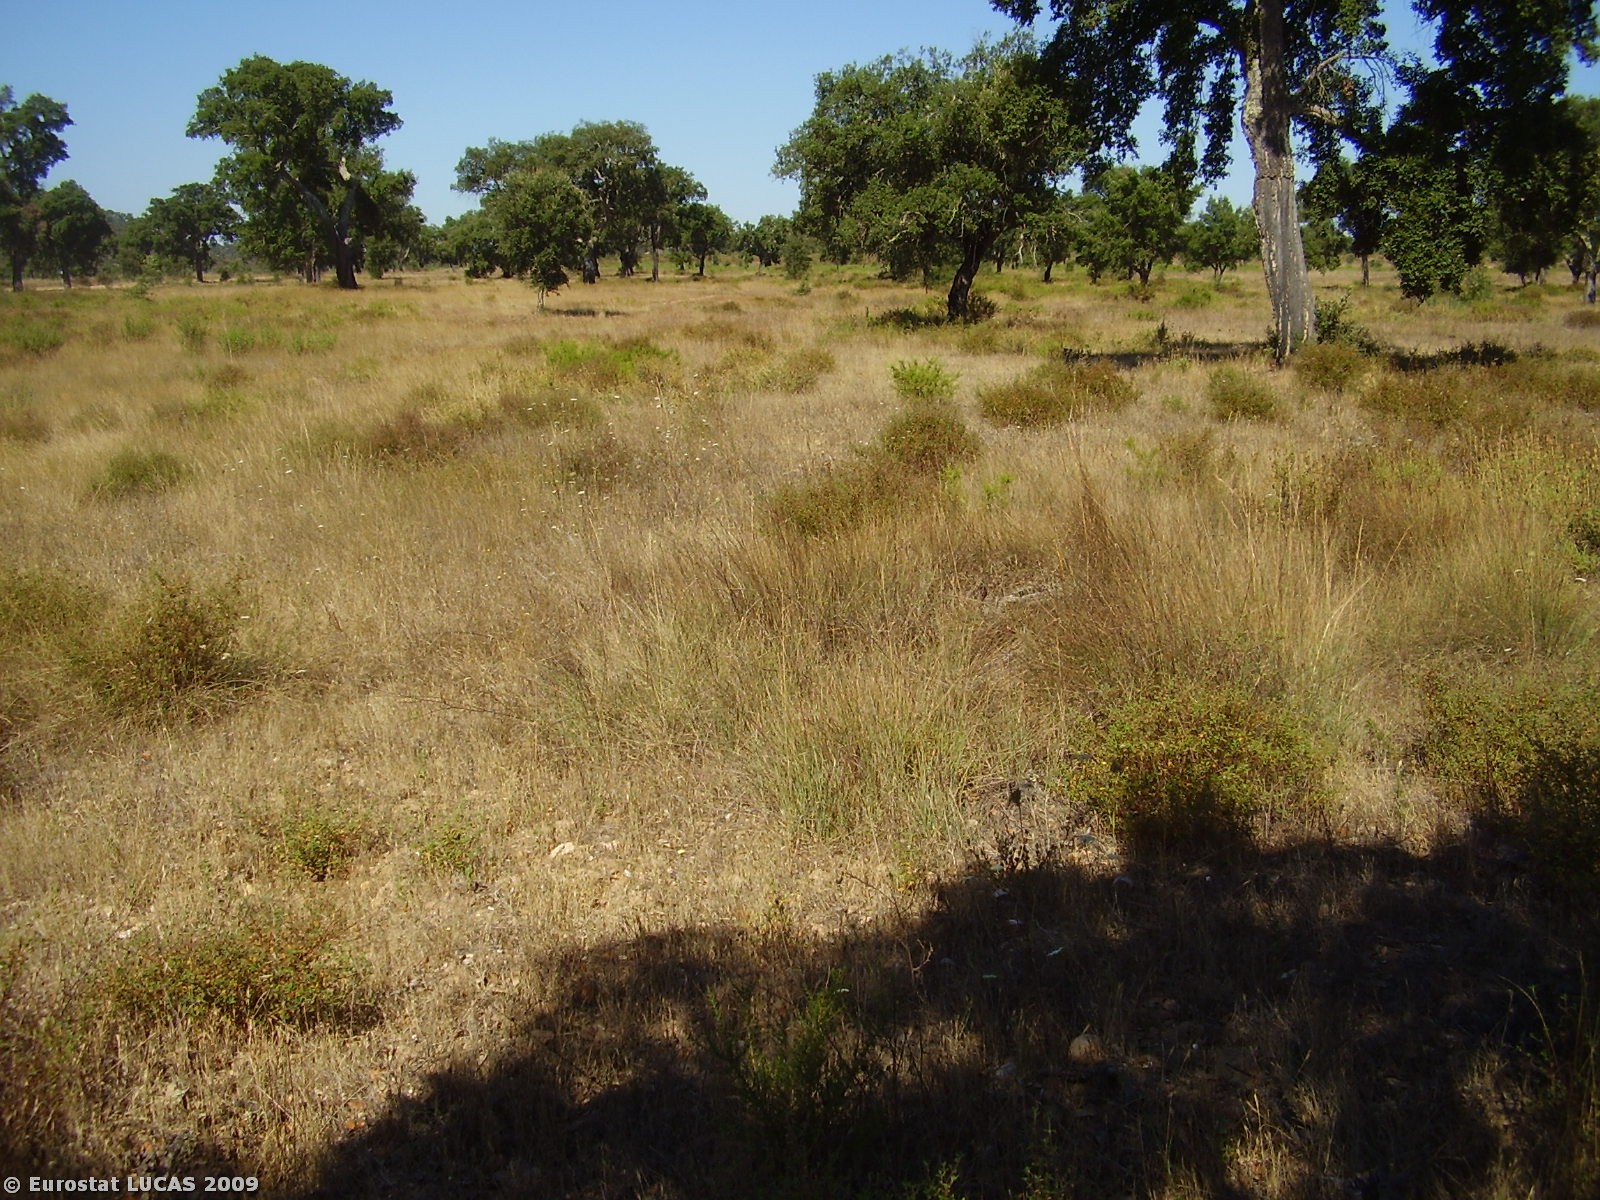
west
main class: Woodland
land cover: Broadleaved woodland
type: broadleaved evergreen forest
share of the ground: < 10 %
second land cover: Spontaneously vegetated surfaces
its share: > 75 %
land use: Forestry
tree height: > 5 m
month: July
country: PT
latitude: 39.3530
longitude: -8.1519
